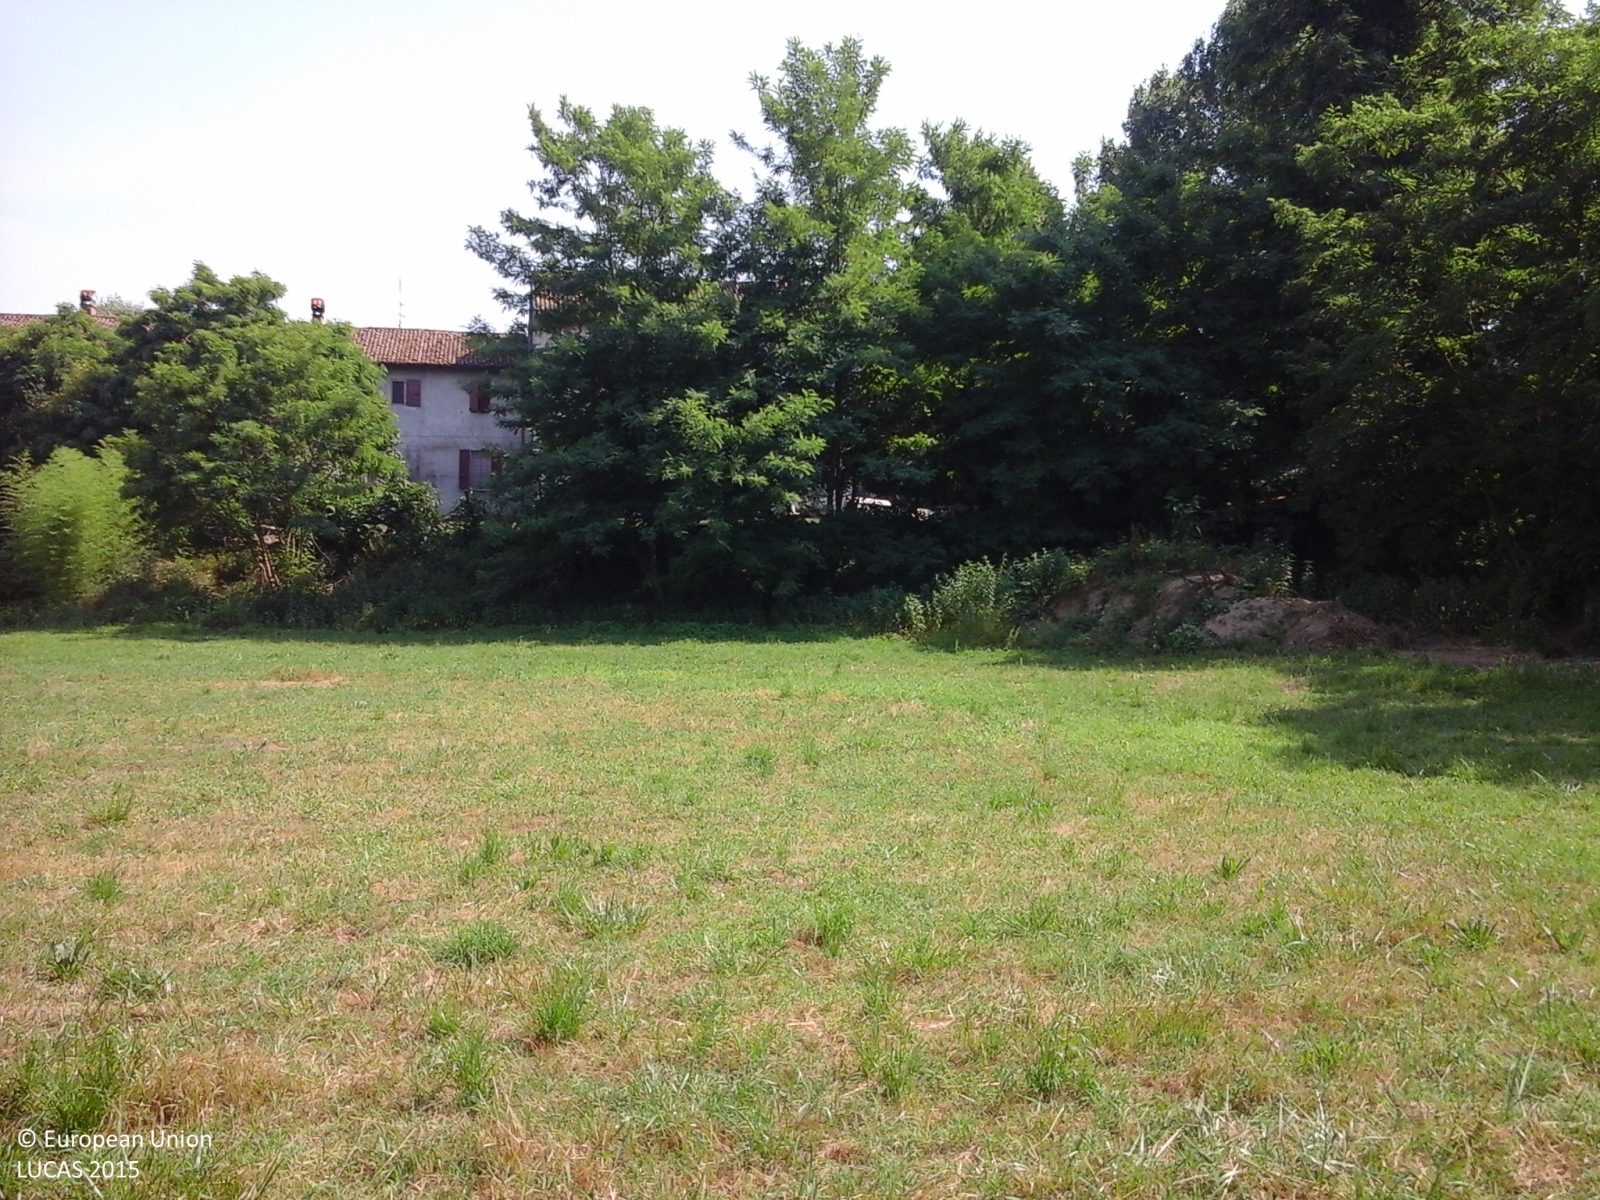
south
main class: Grassland
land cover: Grassland without tree/shrub cover
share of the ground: > 75 %
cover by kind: herbaceous plants 100 %
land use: Agriculture (excluding fallow land and kitchen gardens)
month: June
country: IT
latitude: 45.1614
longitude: 9.6572
